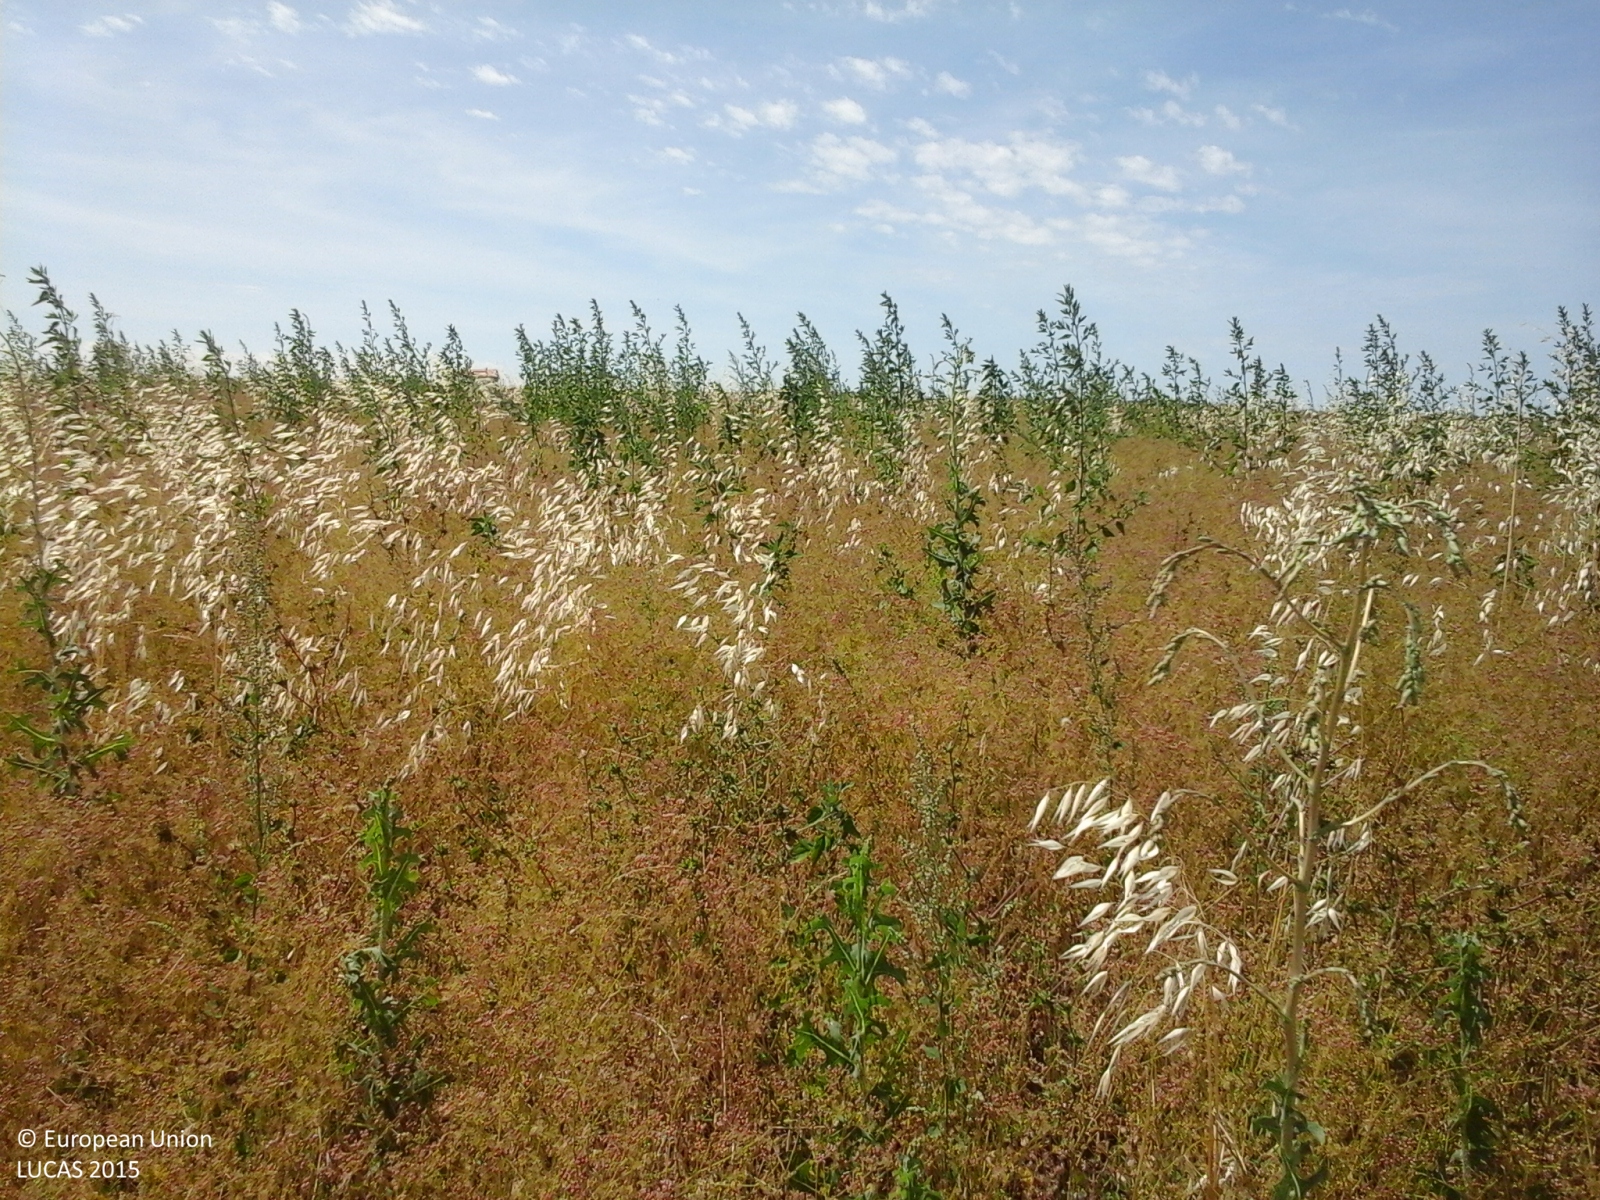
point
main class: Cropland
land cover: Other non-permanent industrial crops
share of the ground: > 75 %
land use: Agriculture (excluding fallow land and kitchen gardens)
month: June
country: IT
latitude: 42.2006
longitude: 14.3102
